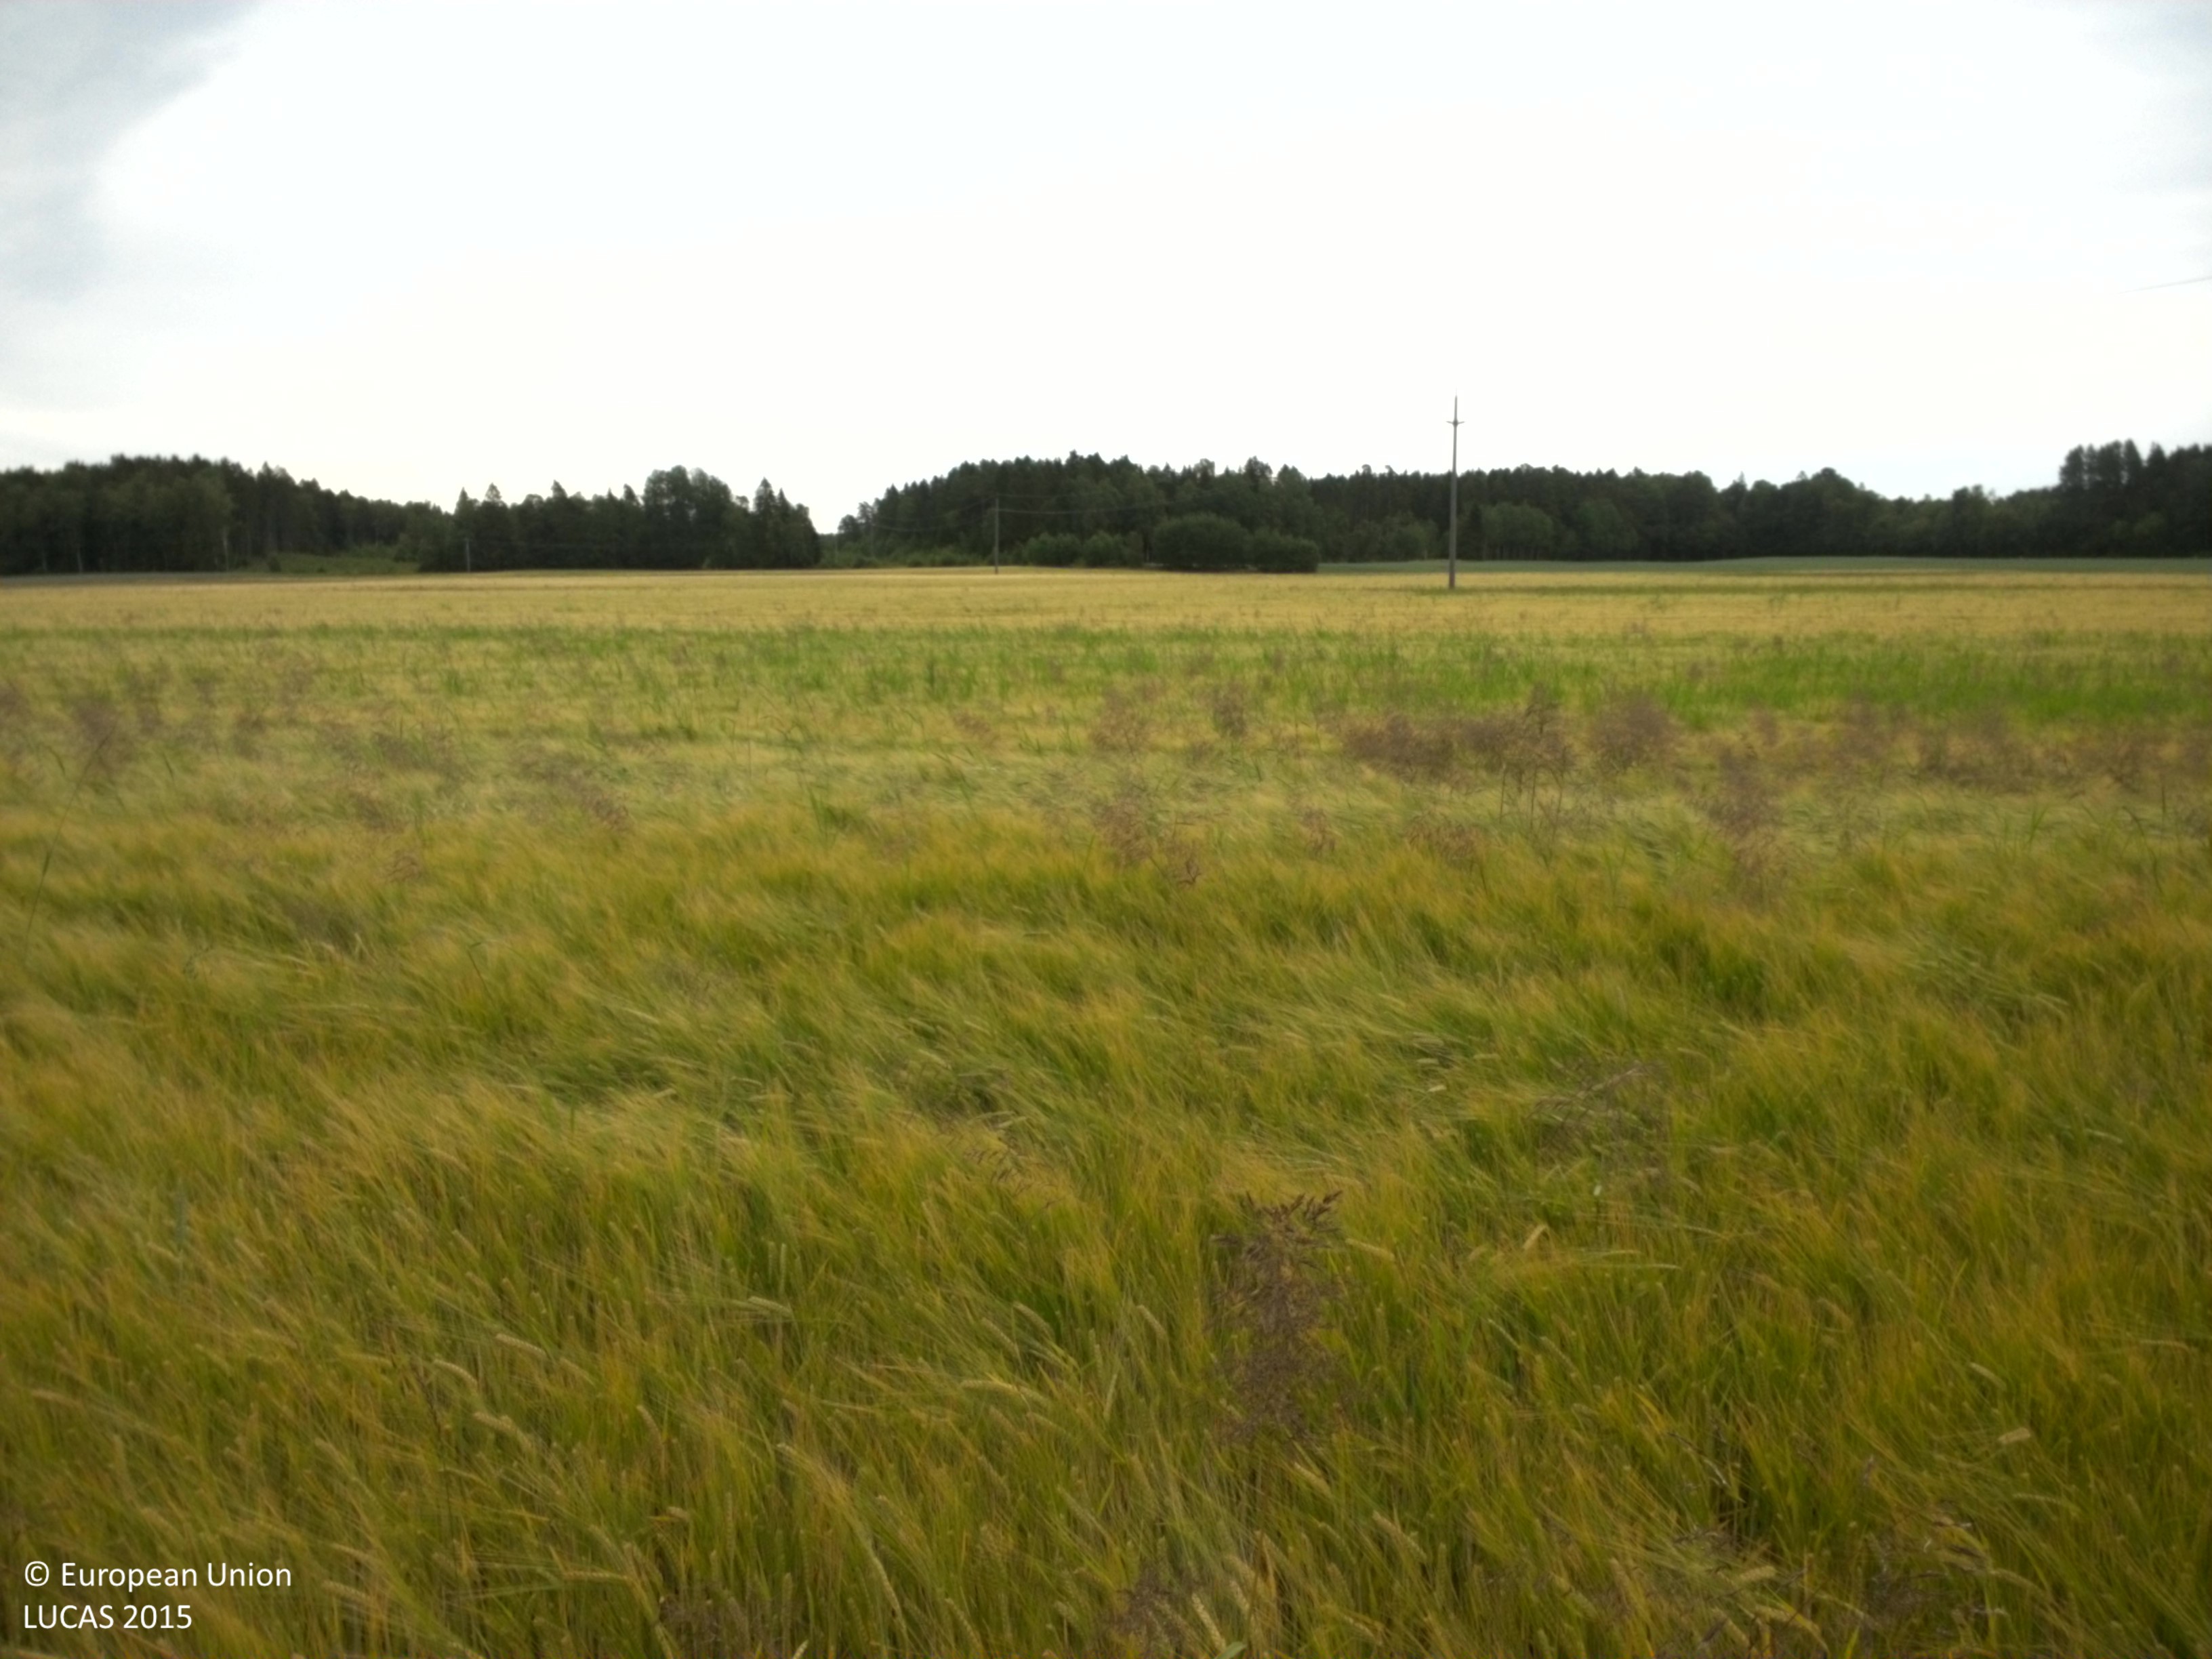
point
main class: Cropland
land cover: Barley
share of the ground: > 75 %
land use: Agriculture (excluding fallow land and kitchen gardens)
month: July
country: SE
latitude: 58.3764
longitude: 13.3285
